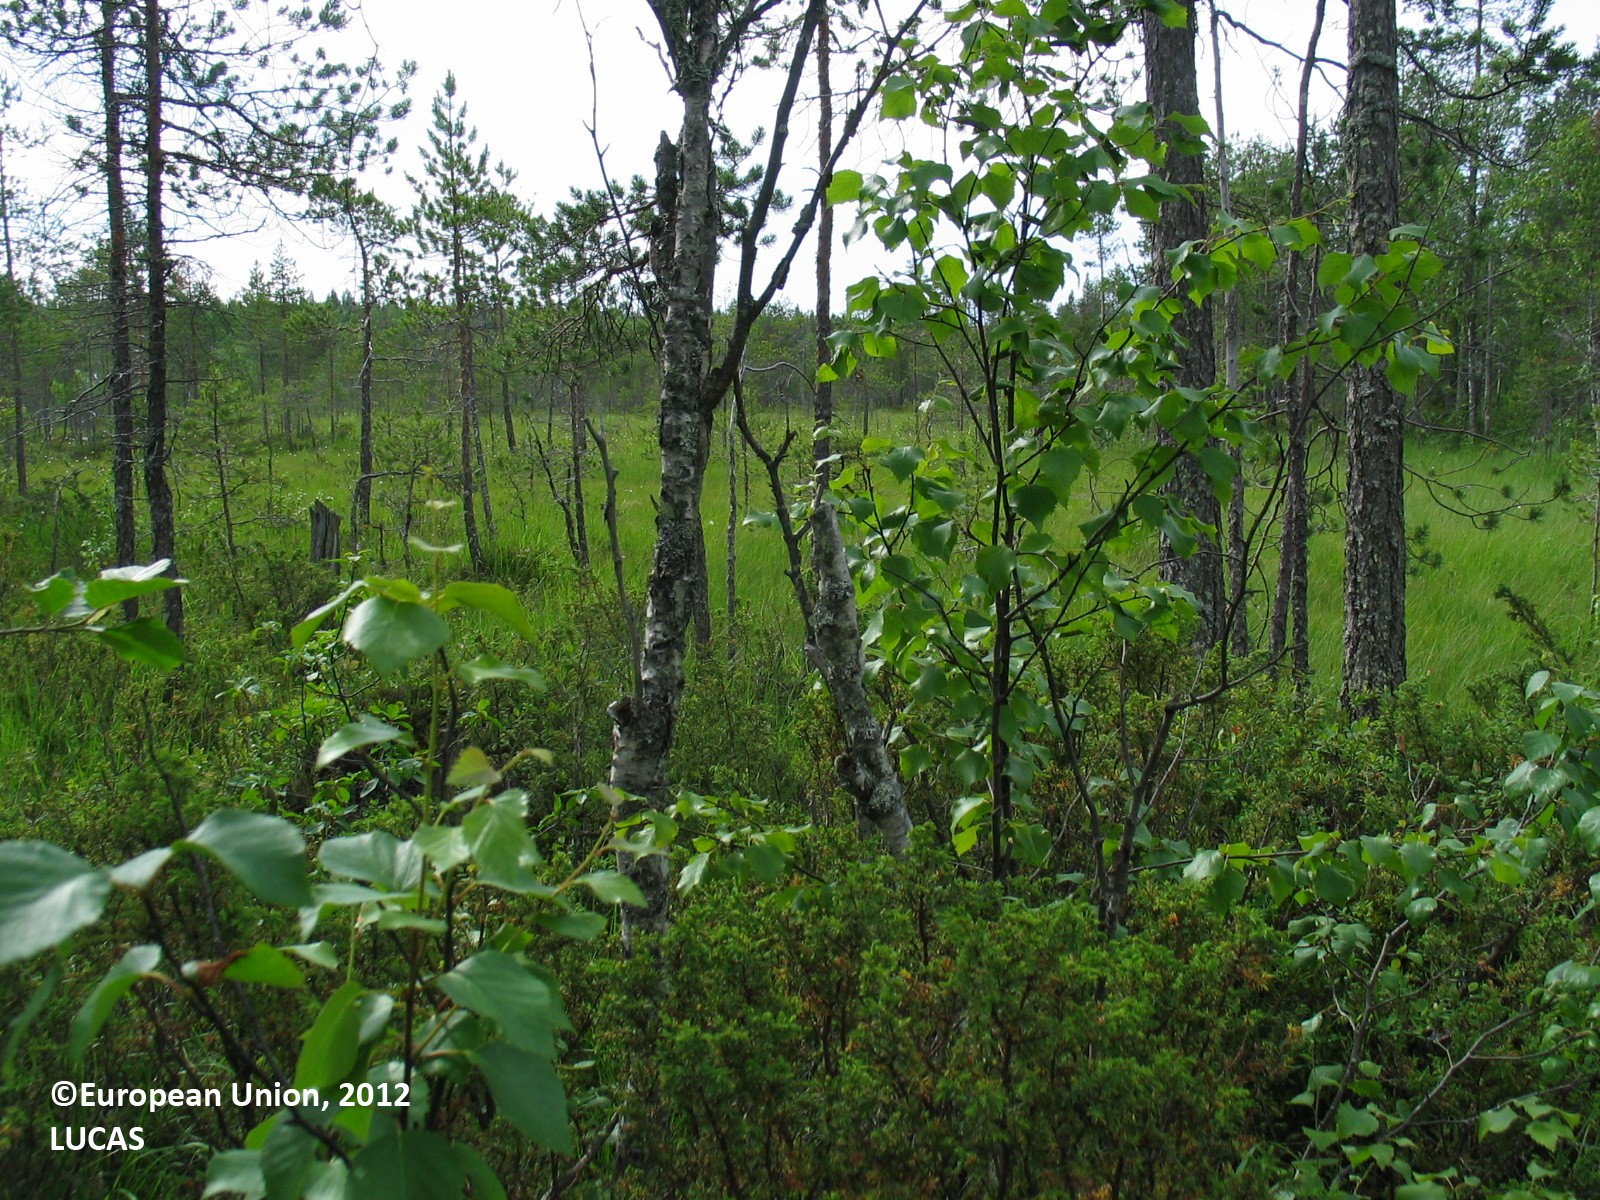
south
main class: Woodland
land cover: Pine dominated coniferous woodland
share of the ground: 25 - 50 %
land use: Semi-natural and natural areas not in use
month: July
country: FI
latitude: 65.9761
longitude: 25.1424
